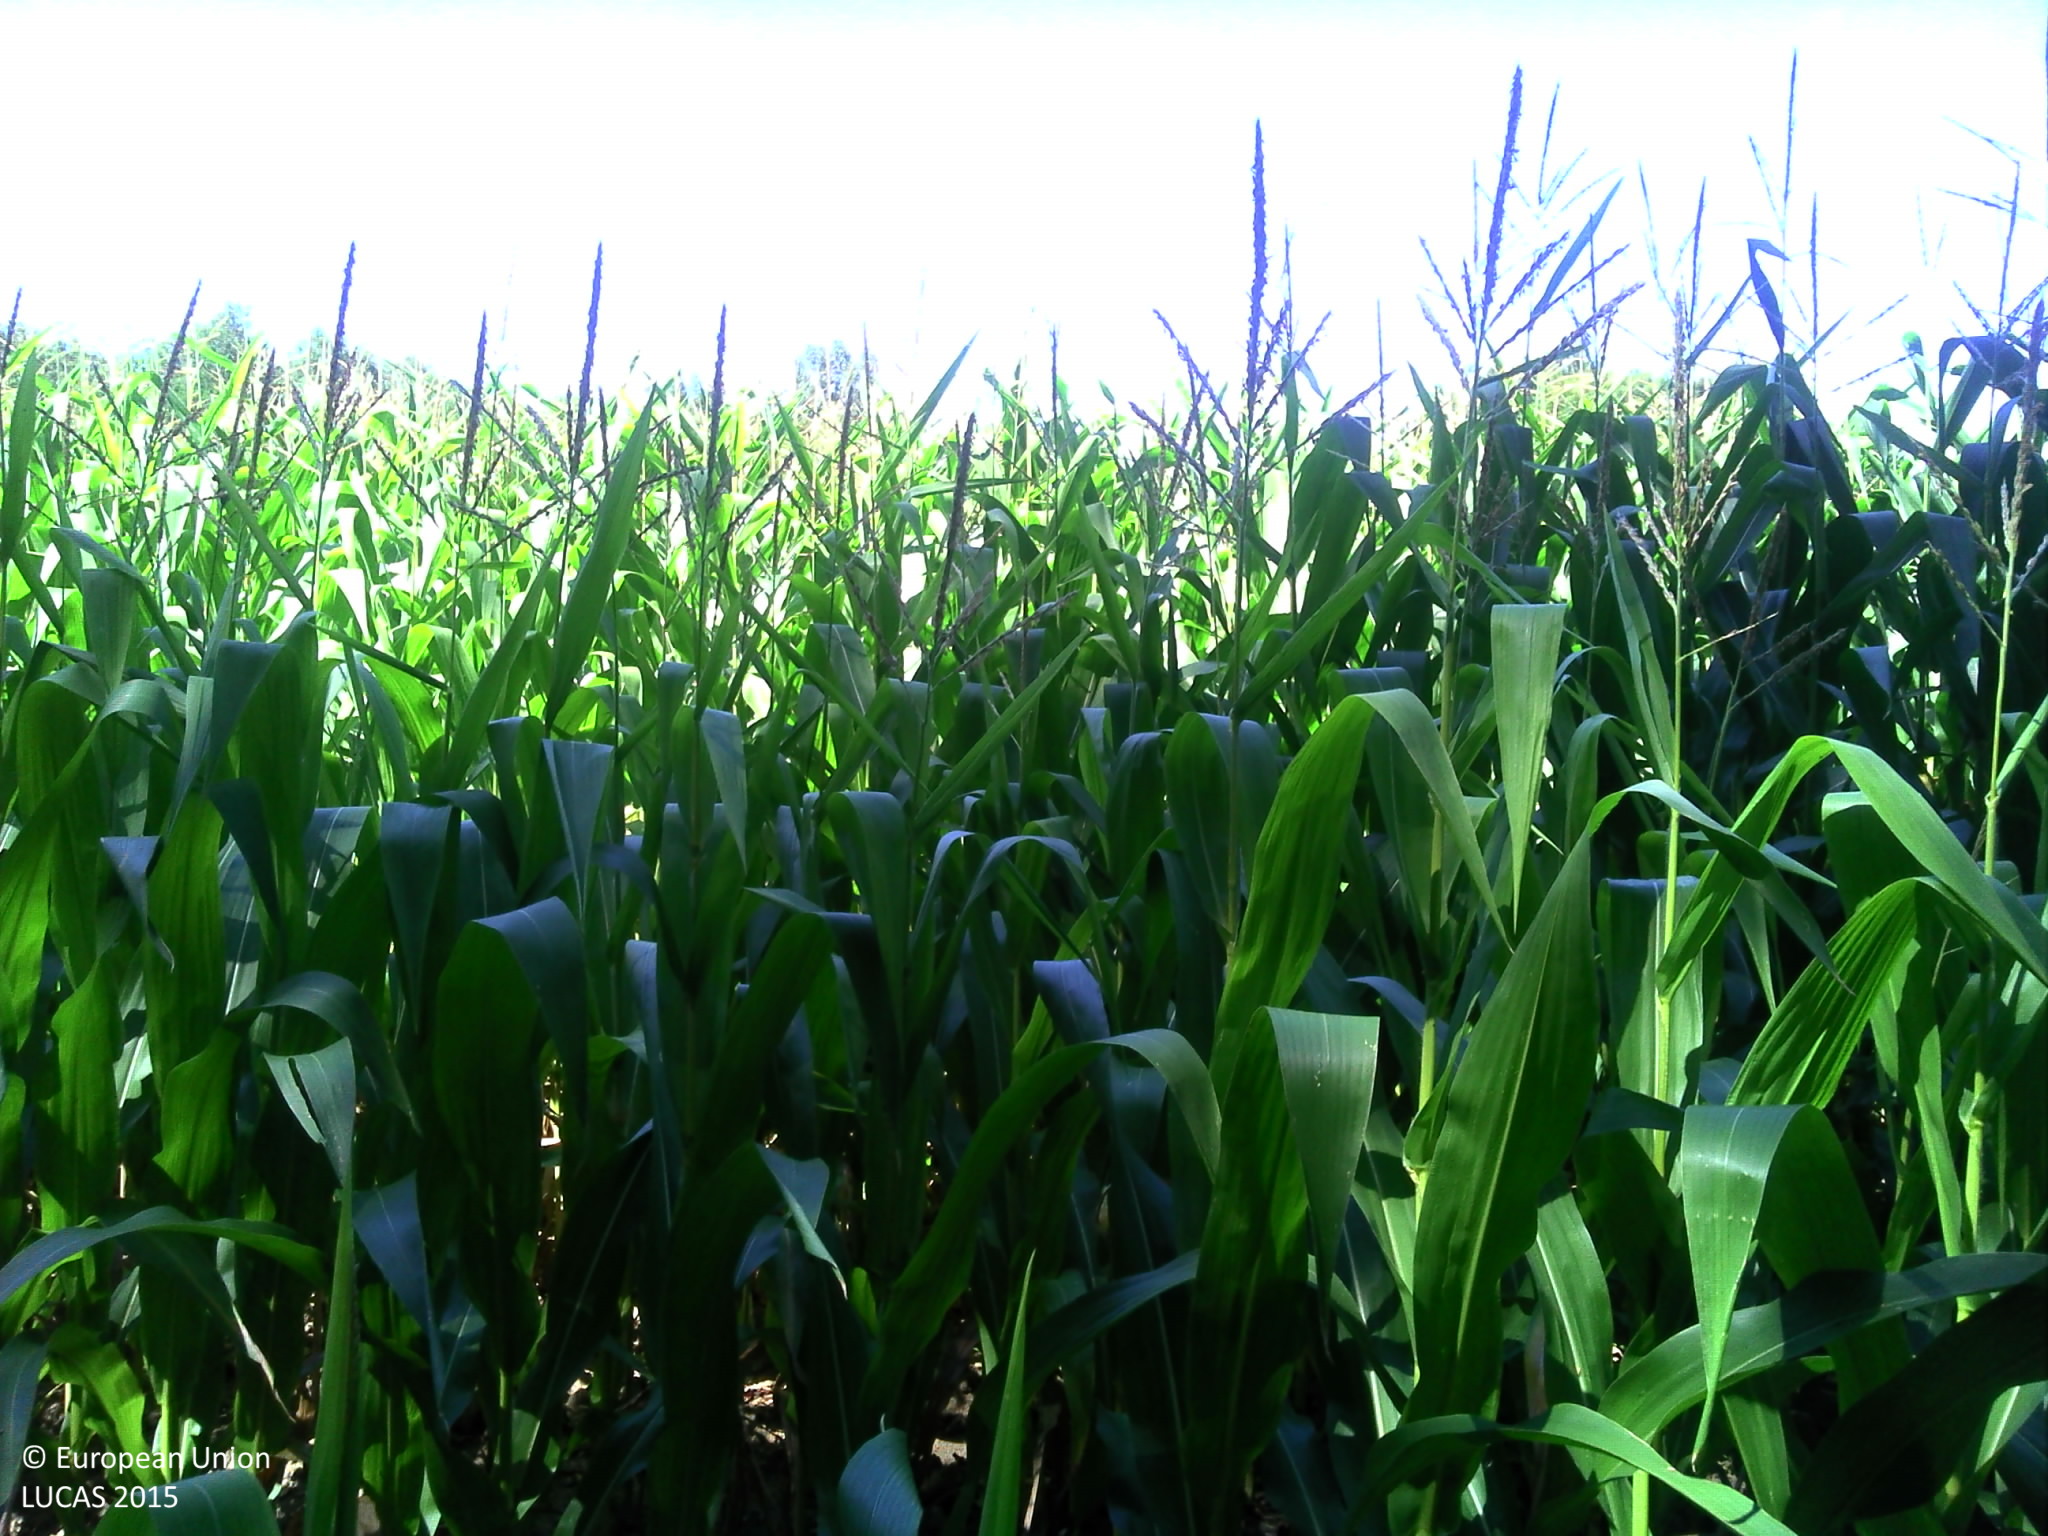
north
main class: Cropland
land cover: Maize
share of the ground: > 75 %
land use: Agriculture (excluding fallow land and kitchen gardens)
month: July
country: FR
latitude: 45.6410
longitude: 5.4498
